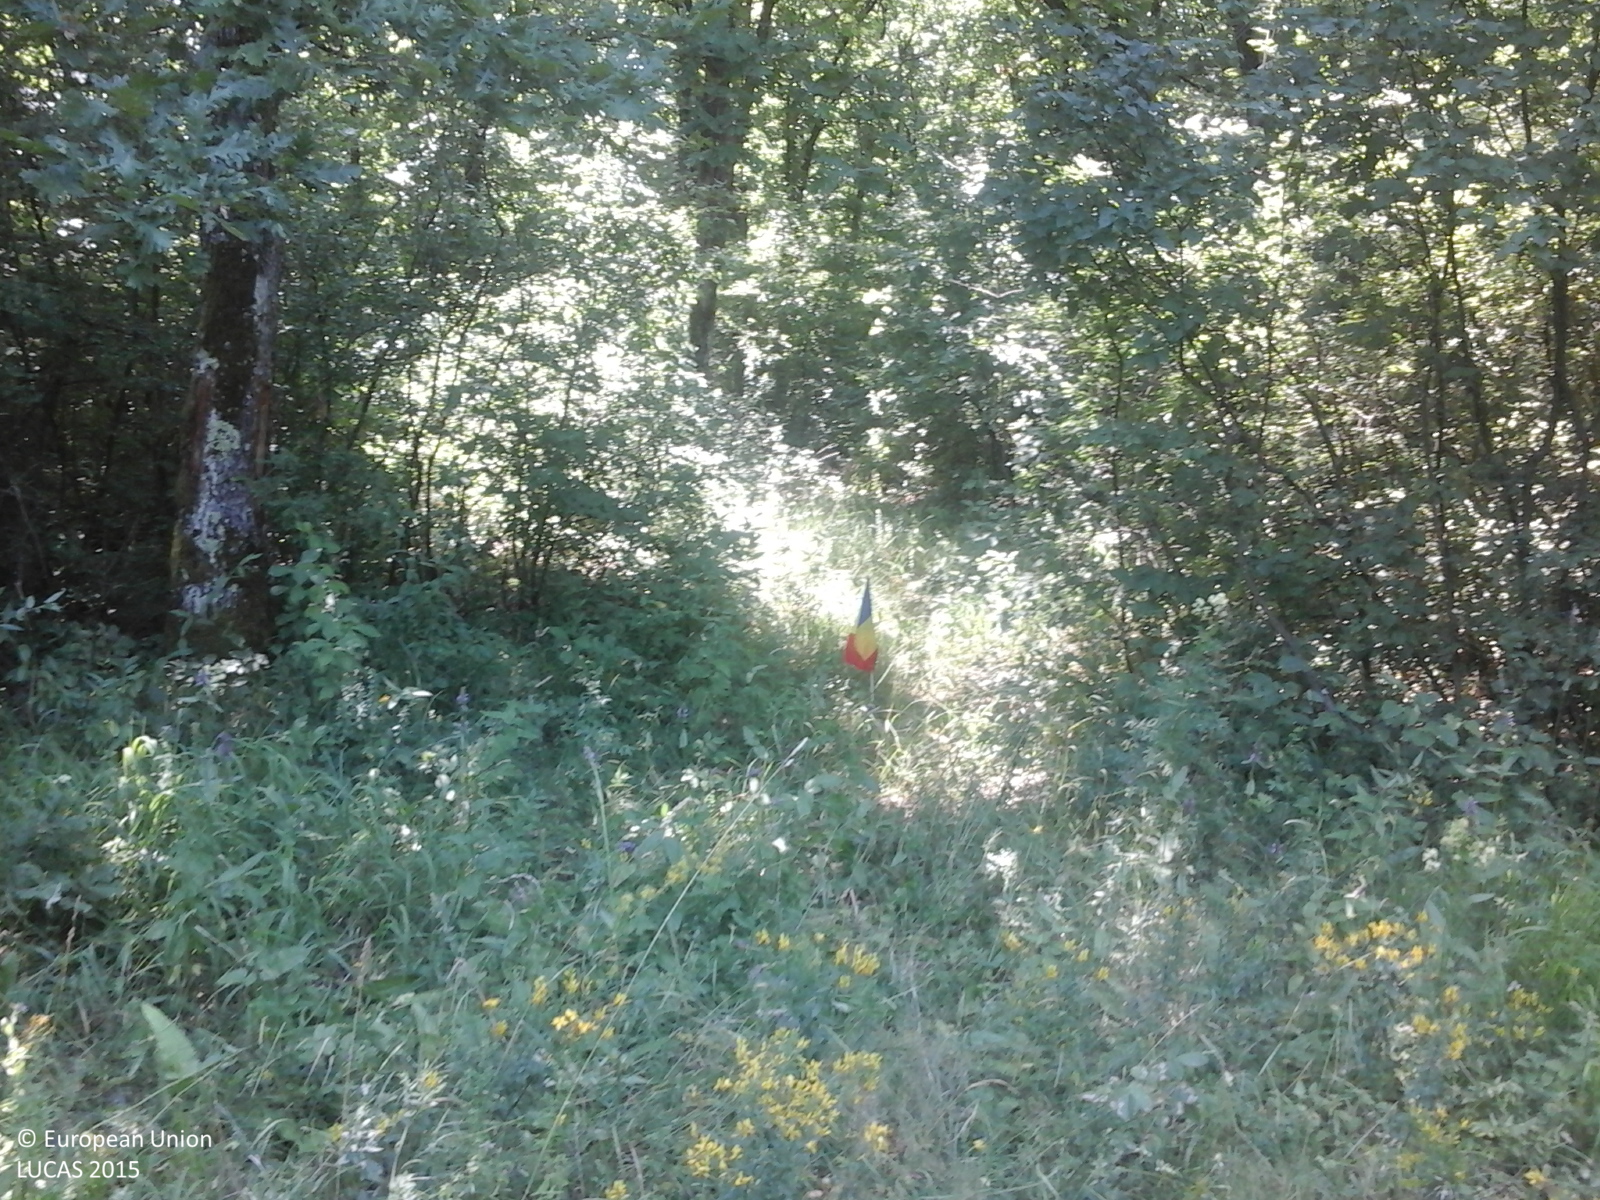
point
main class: Woodland
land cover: Broadleaved woodland
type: acidophilous oak and oak-birch forest
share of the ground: > 75 %
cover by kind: broadleaved forest trees 100 %
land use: Forestry
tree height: > 5 m
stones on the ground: < 10 %
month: July
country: RO
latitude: 44.6630
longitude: 24.3594
